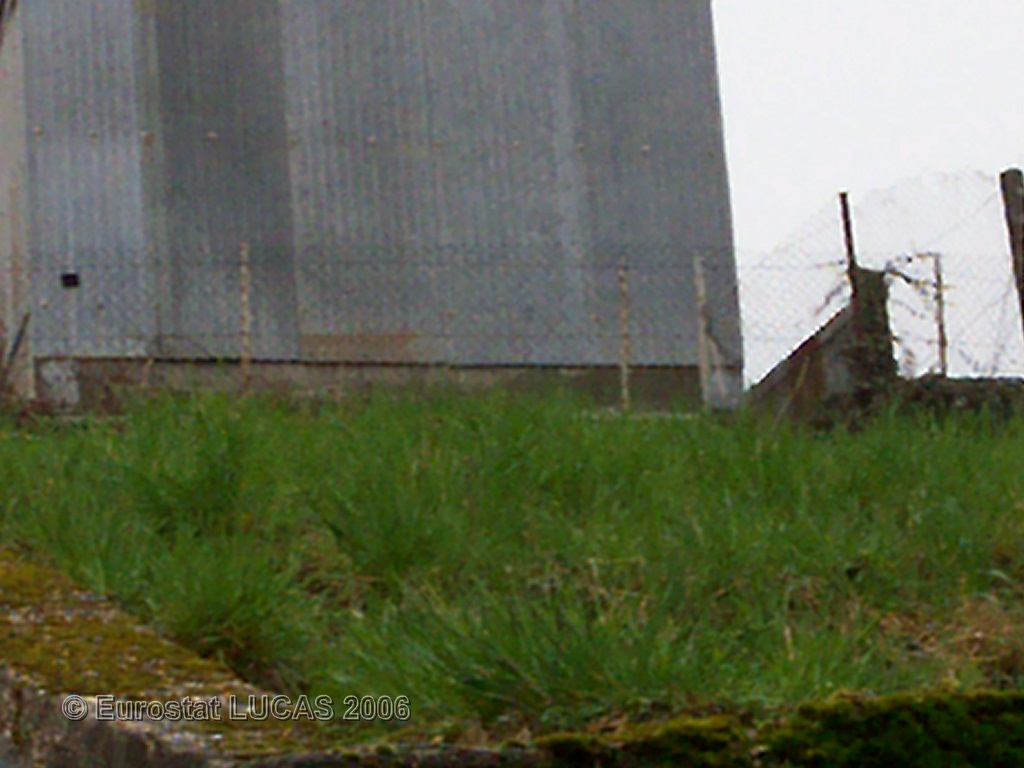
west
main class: Grassland
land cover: Grassland with sparse tree/shrub cover
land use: Residential
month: April
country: FR
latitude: 48.6711
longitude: 7.0811
